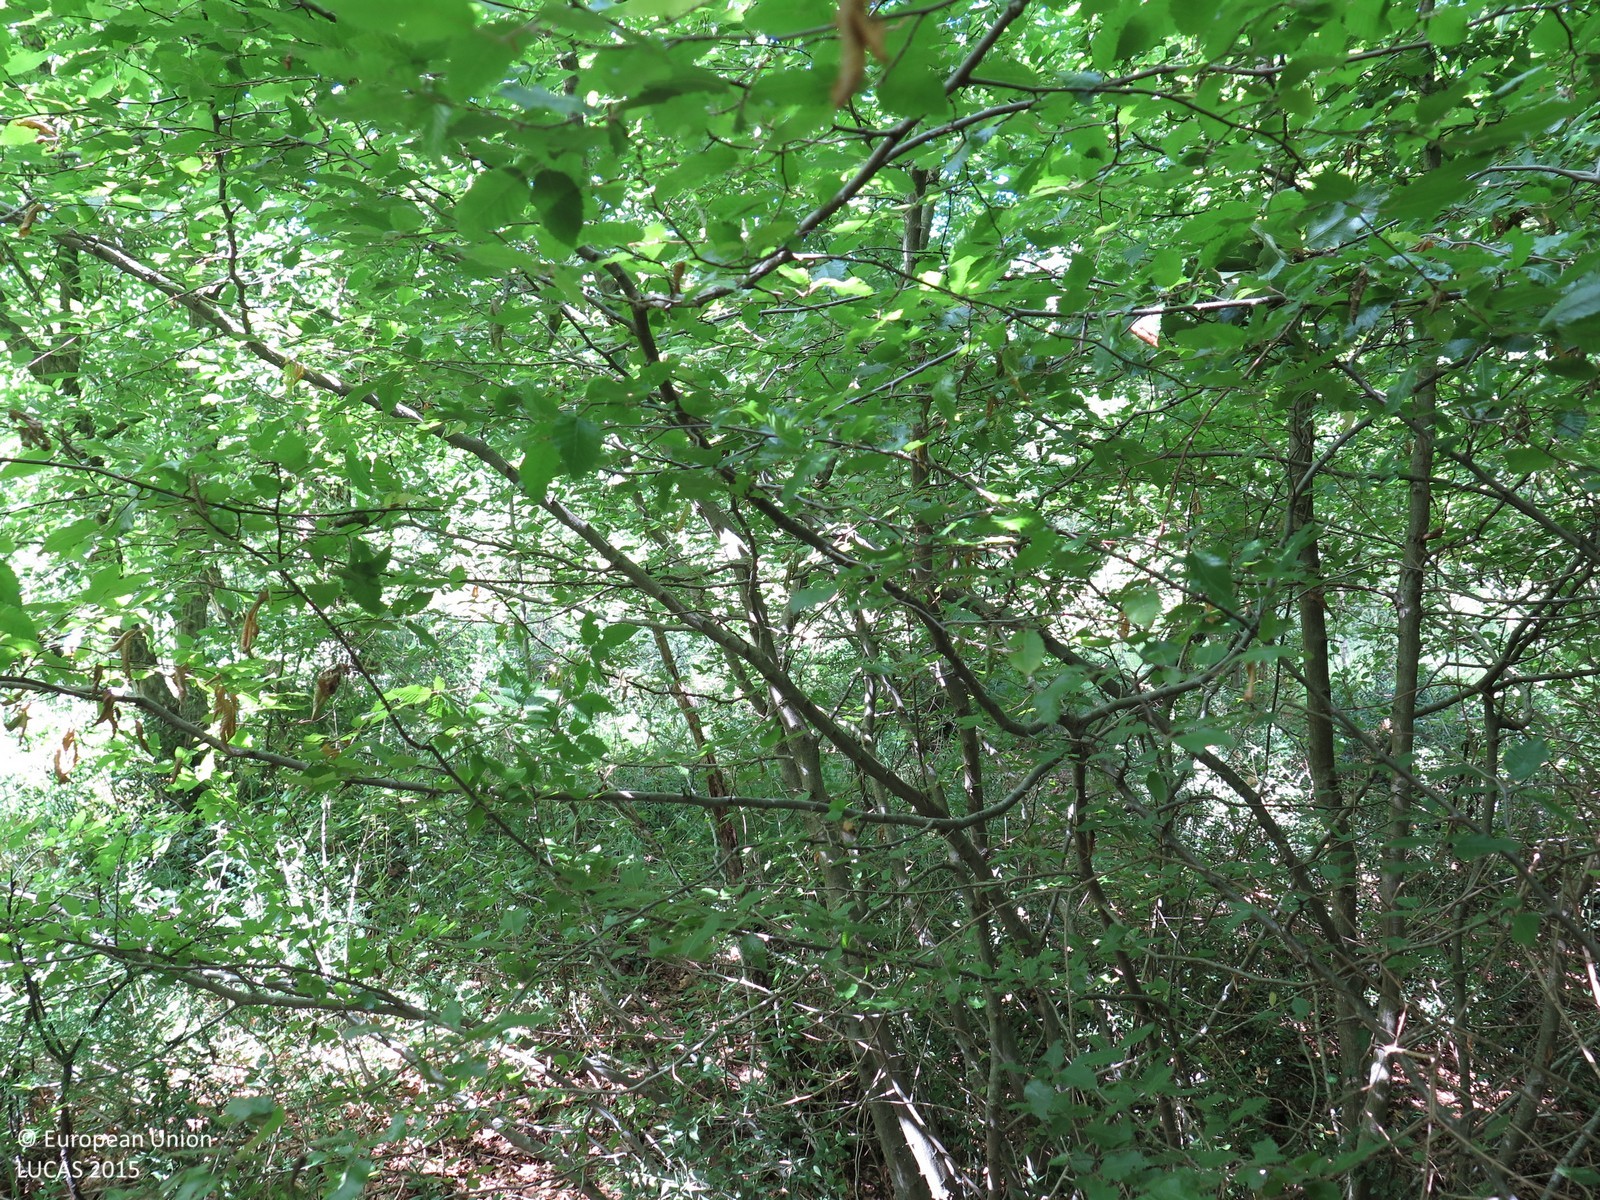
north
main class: Woodland
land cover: Broadleaved woodland
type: beech forest
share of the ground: > 75 %
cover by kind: broadleaved forest trees 90 %, shrubs 5 %, herbaceous plants 5 %
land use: Semi-natural and natural areas not in use
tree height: > 5 m
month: June
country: HR
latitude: 45.2608
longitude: 13.6524
